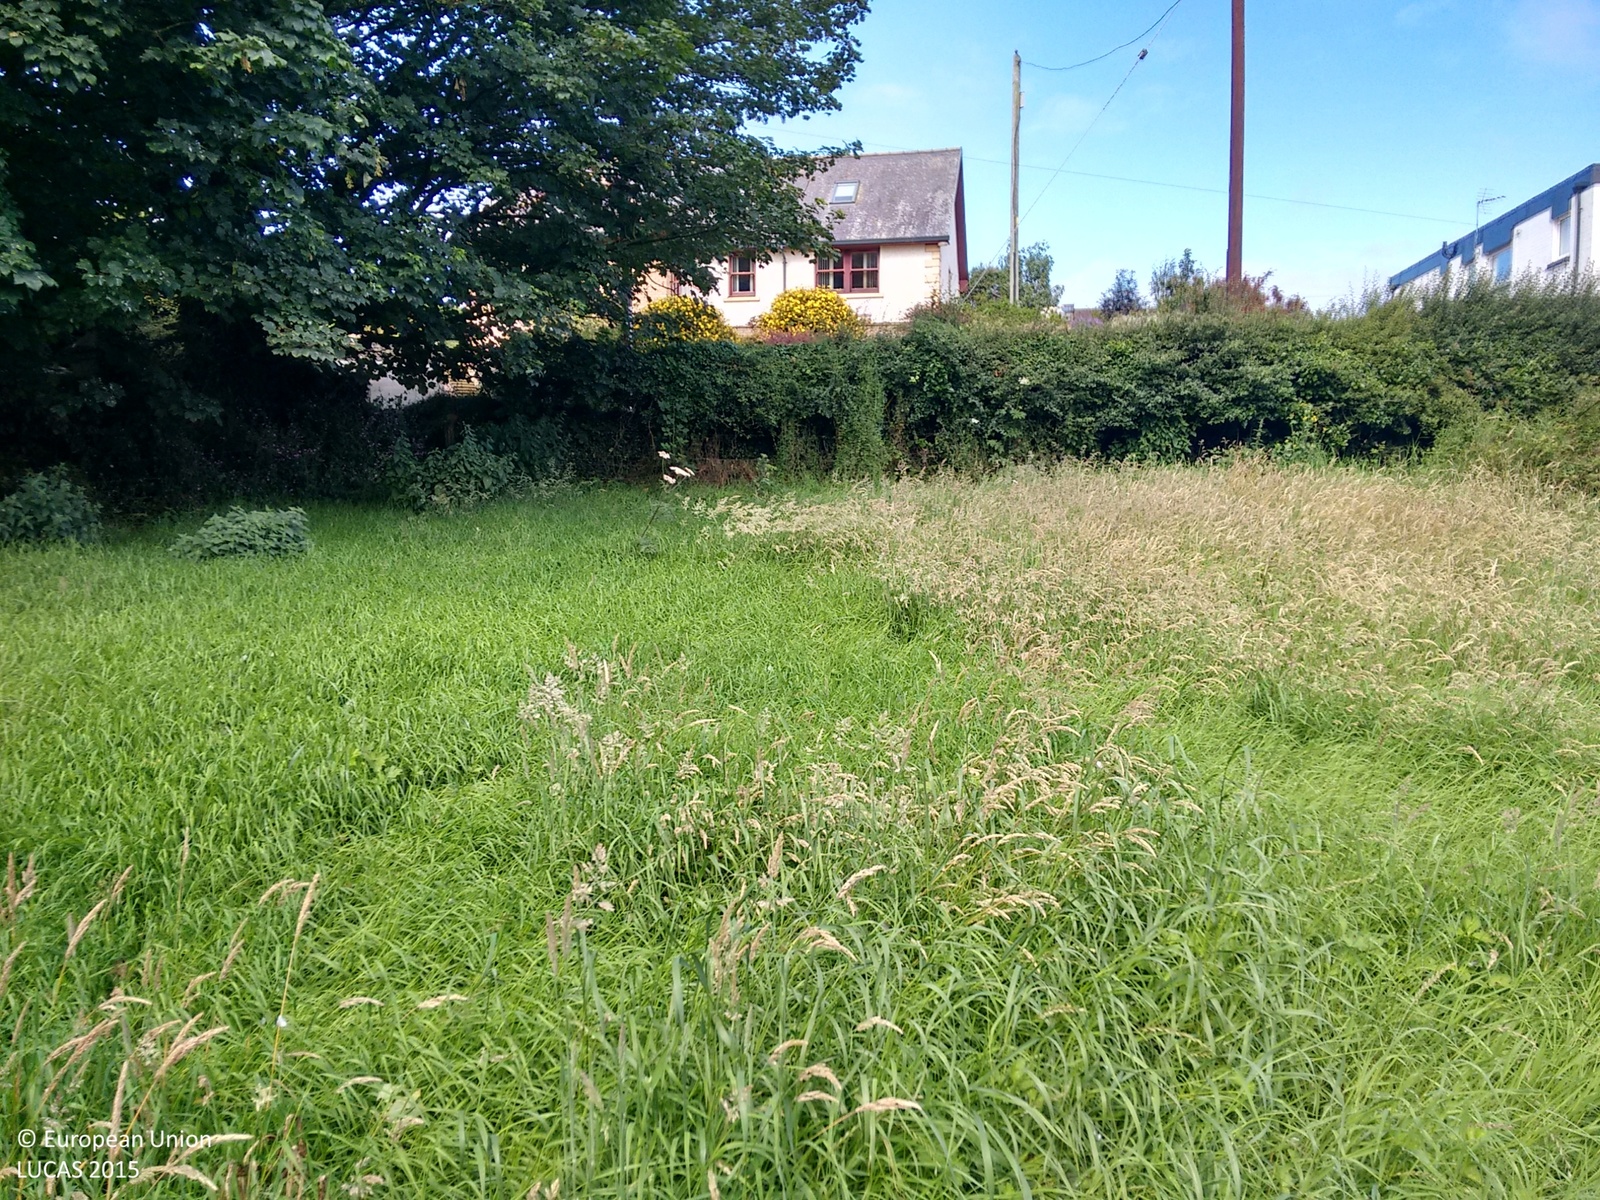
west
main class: Grassland
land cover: Grassland with sparse tree/shrub cover
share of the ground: > 75 %
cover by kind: herbaceous plants 95 %, broadleaved forest trees 5 %
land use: Agriculture (excluding fallow land and kitchen gardens)
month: August
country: GB
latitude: 54.6885
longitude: -4.8956
